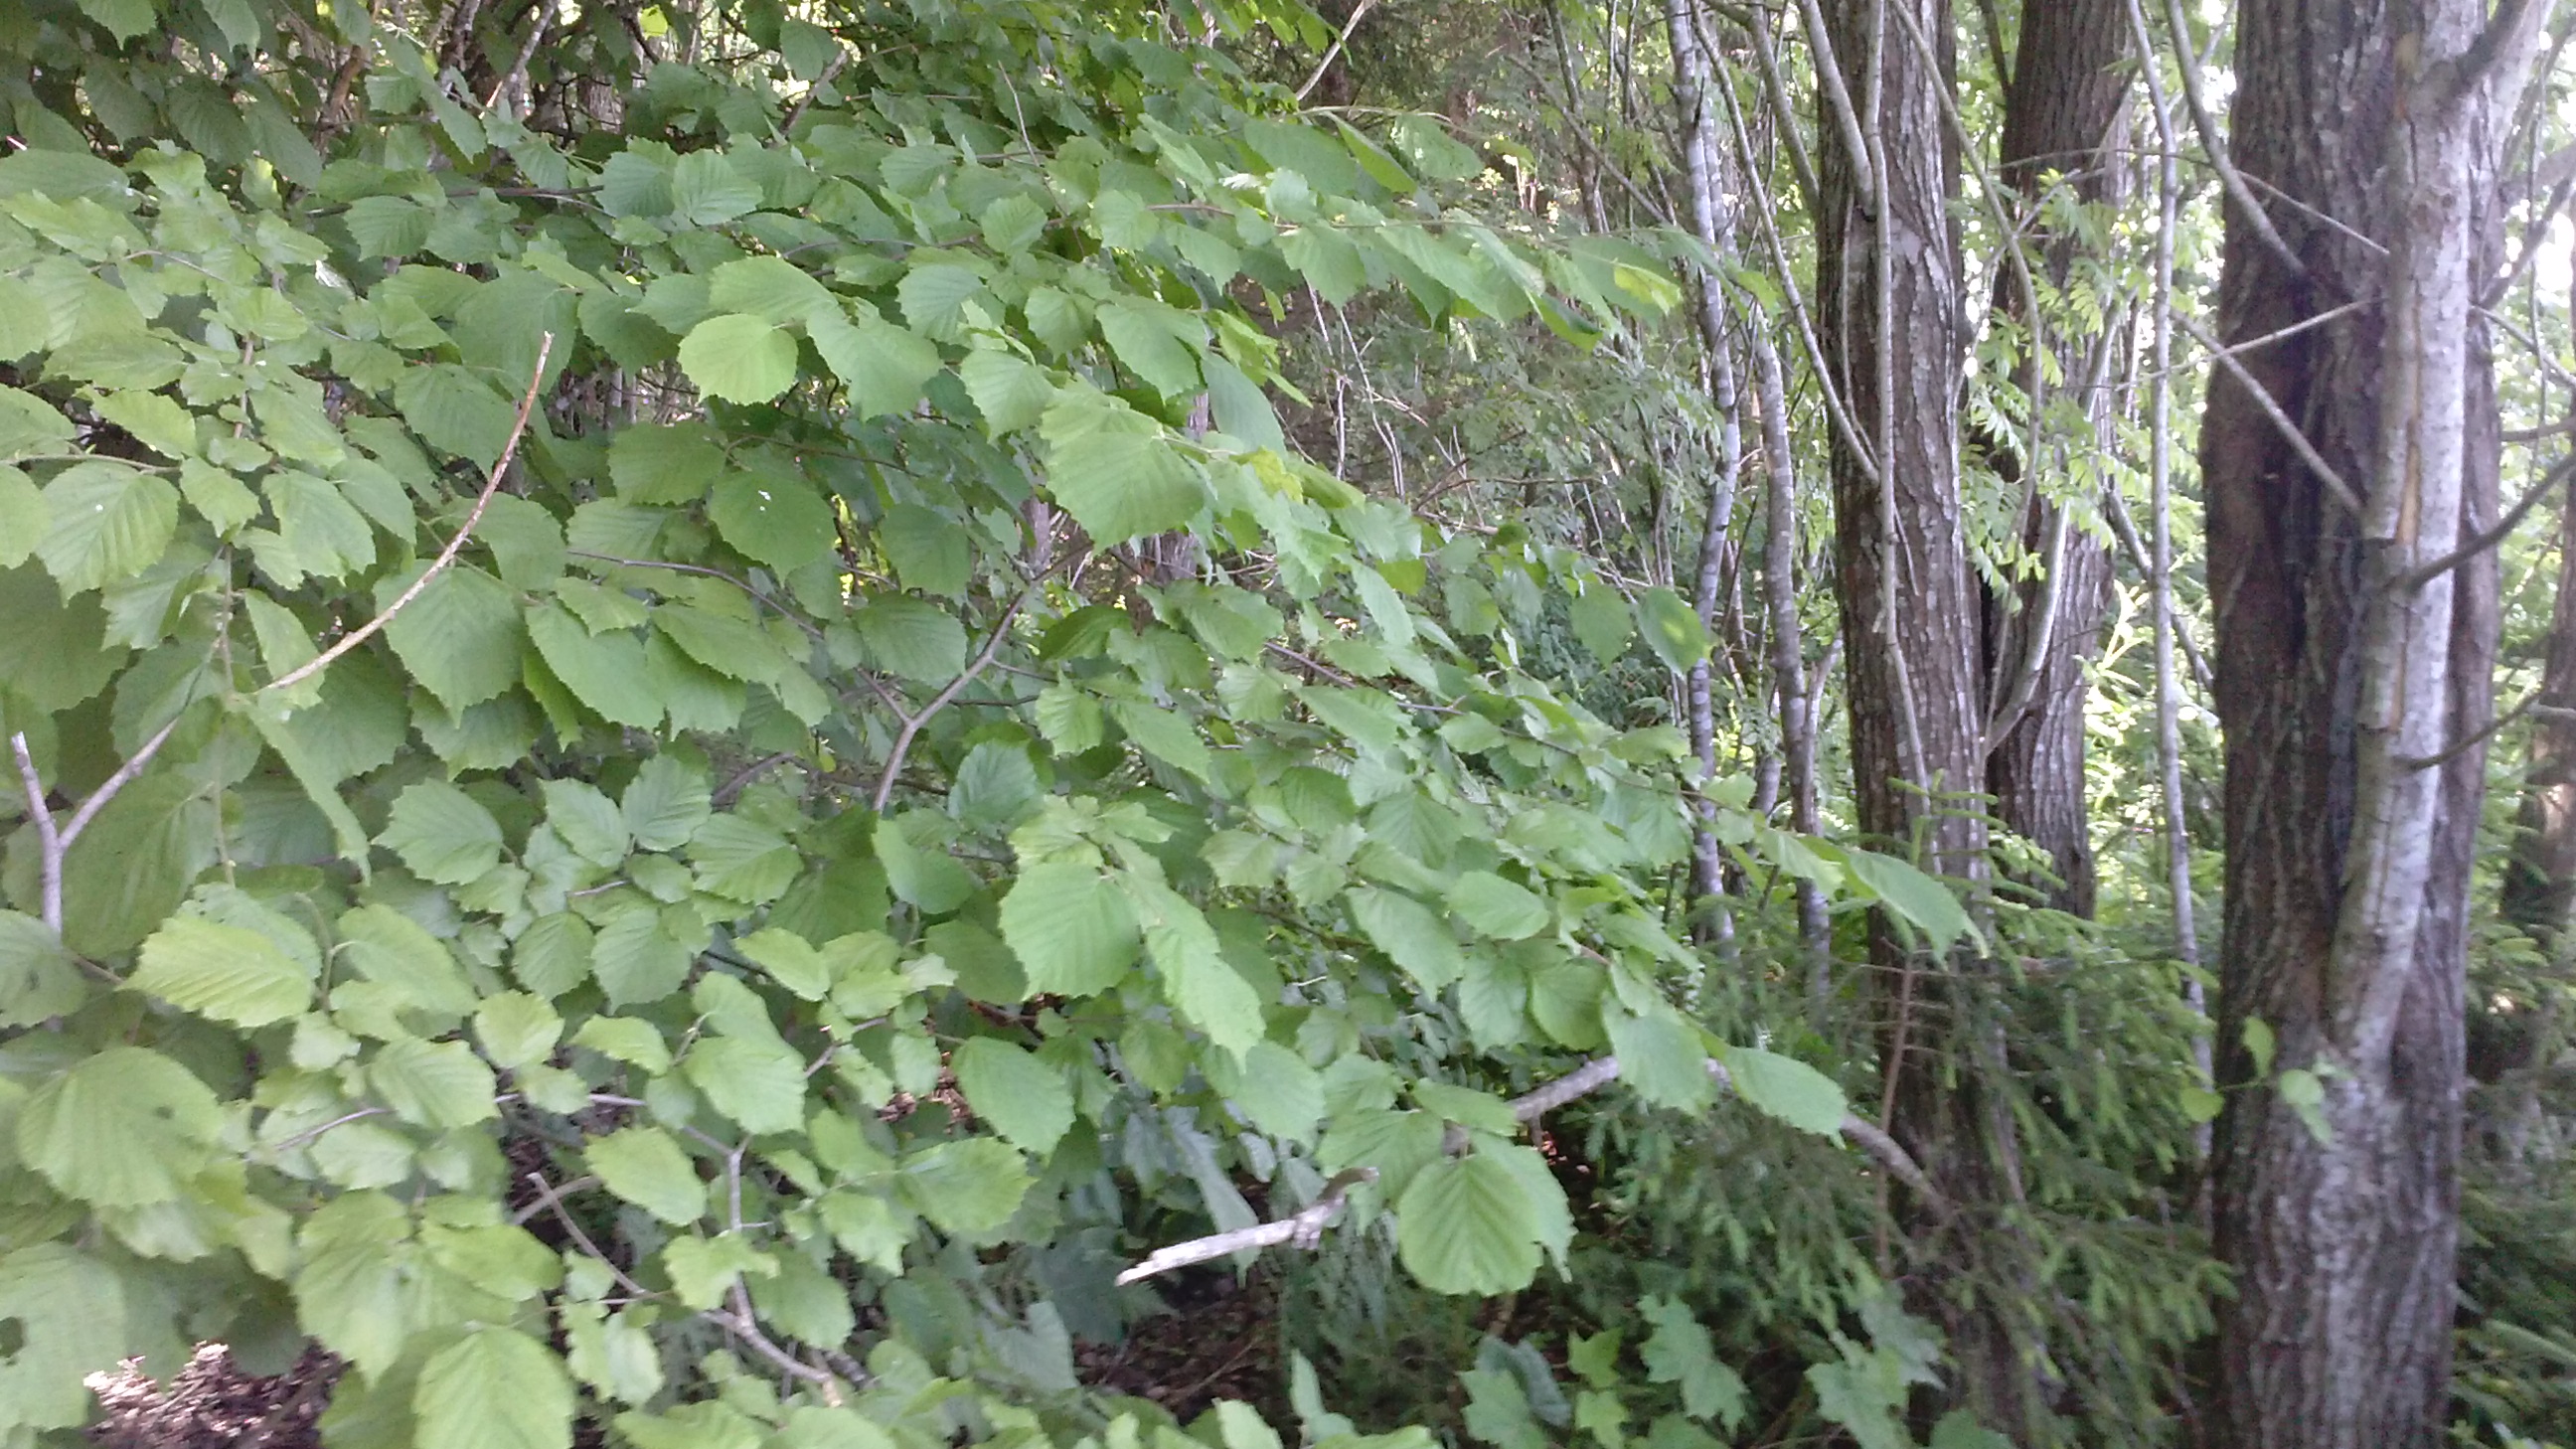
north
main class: Woodland
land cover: Broadleaved woodland
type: non-riverine alder, birch or aspen forest
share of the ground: > 75 %
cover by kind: broadleaved forest trees 80 %, herbaceous plants 10 %, coniferous forest trees 5 %, shrubs 5 %
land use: Forestry
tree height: > 5 m
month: June
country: LV
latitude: 56.5172
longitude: 27.9254
